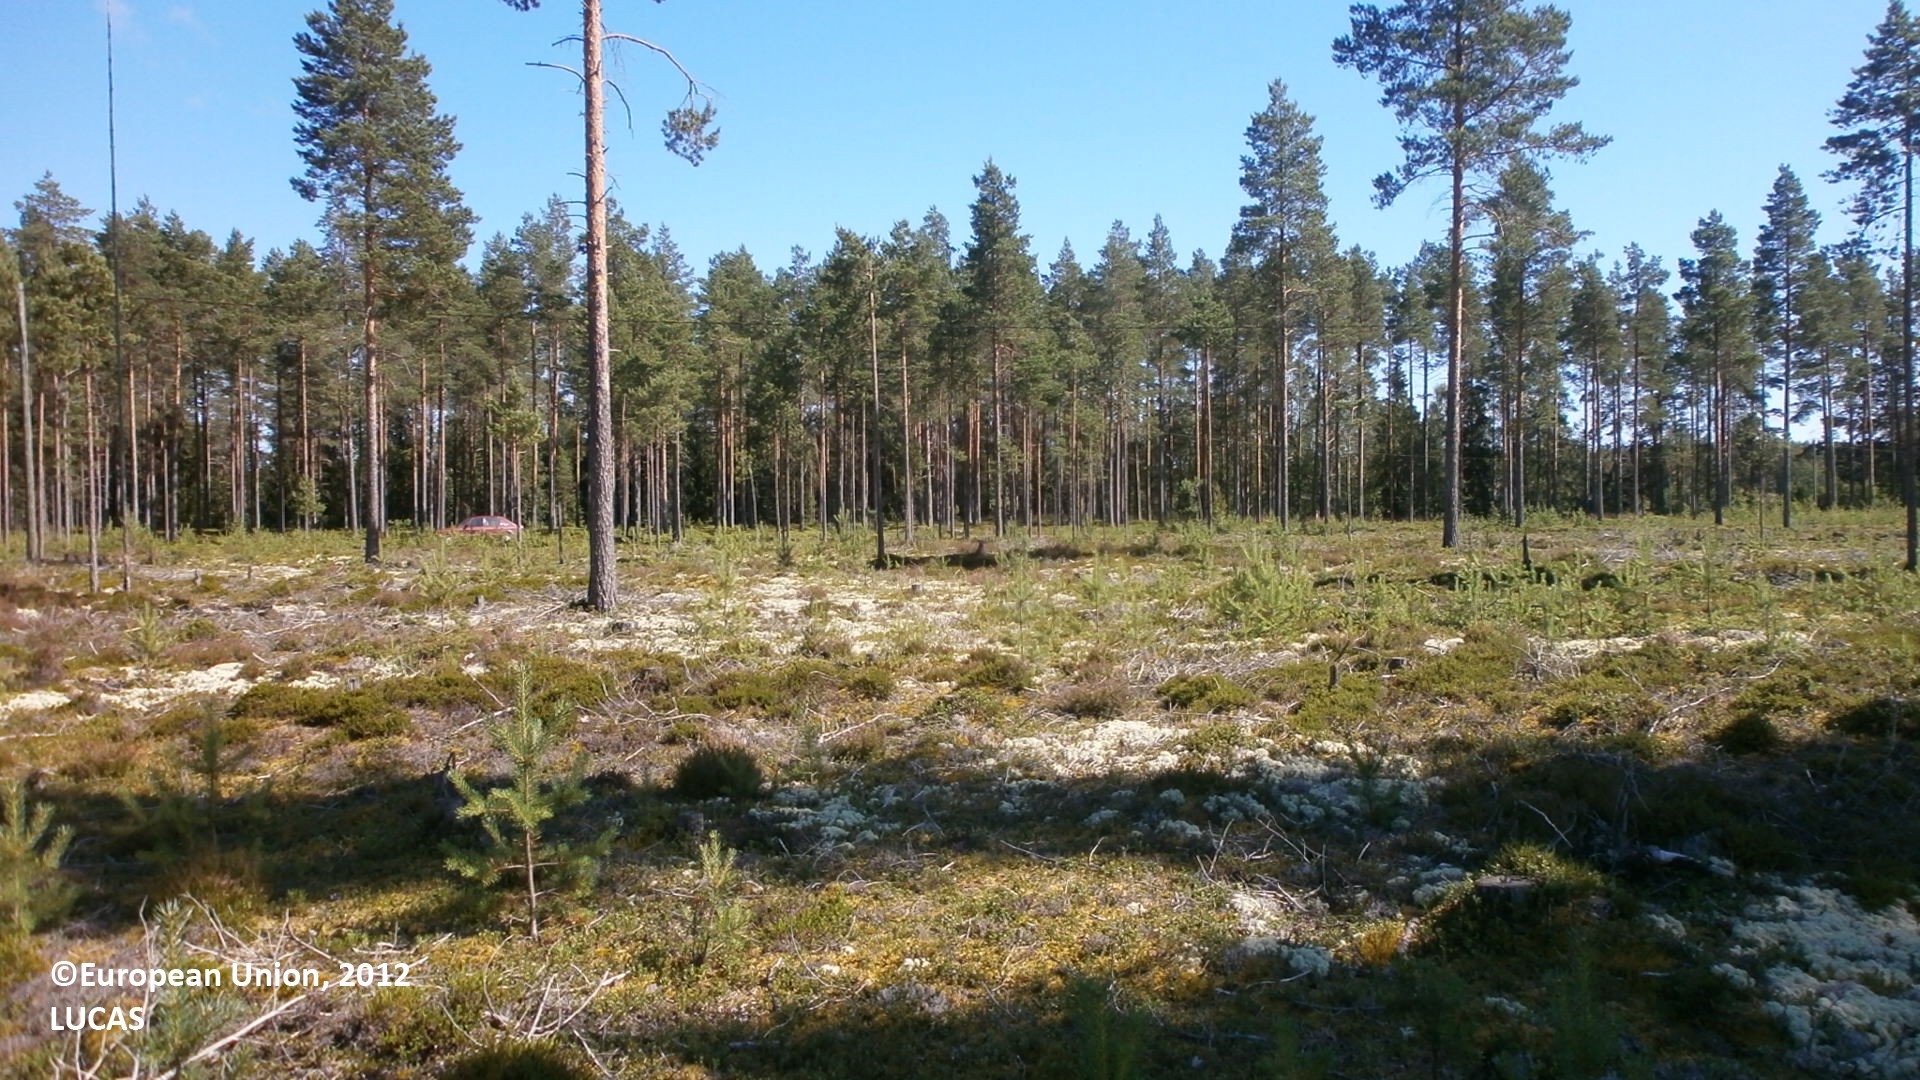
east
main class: Woodland
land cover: Pine dominated coniferous woodland
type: boreal forest
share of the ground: 10 - 25 %
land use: Forestry
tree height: > 5 m
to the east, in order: Pine dominated coniferous woodland; Electric lines; Pine dominated coniferous woodland; Tracks; Electric lines; Pine dominated coniferous woodland; Spruce dominated coniferous woodland; Inland running water; Broadleaved woodland; Pine dominated mixed woodland; Shrubland with sparse tree cover; Single bushes/trees; Shrubland with sparse tree cover; Pine dominated coniferous woodland
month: July
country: FI
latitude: 64.1579
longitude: 23.8165
